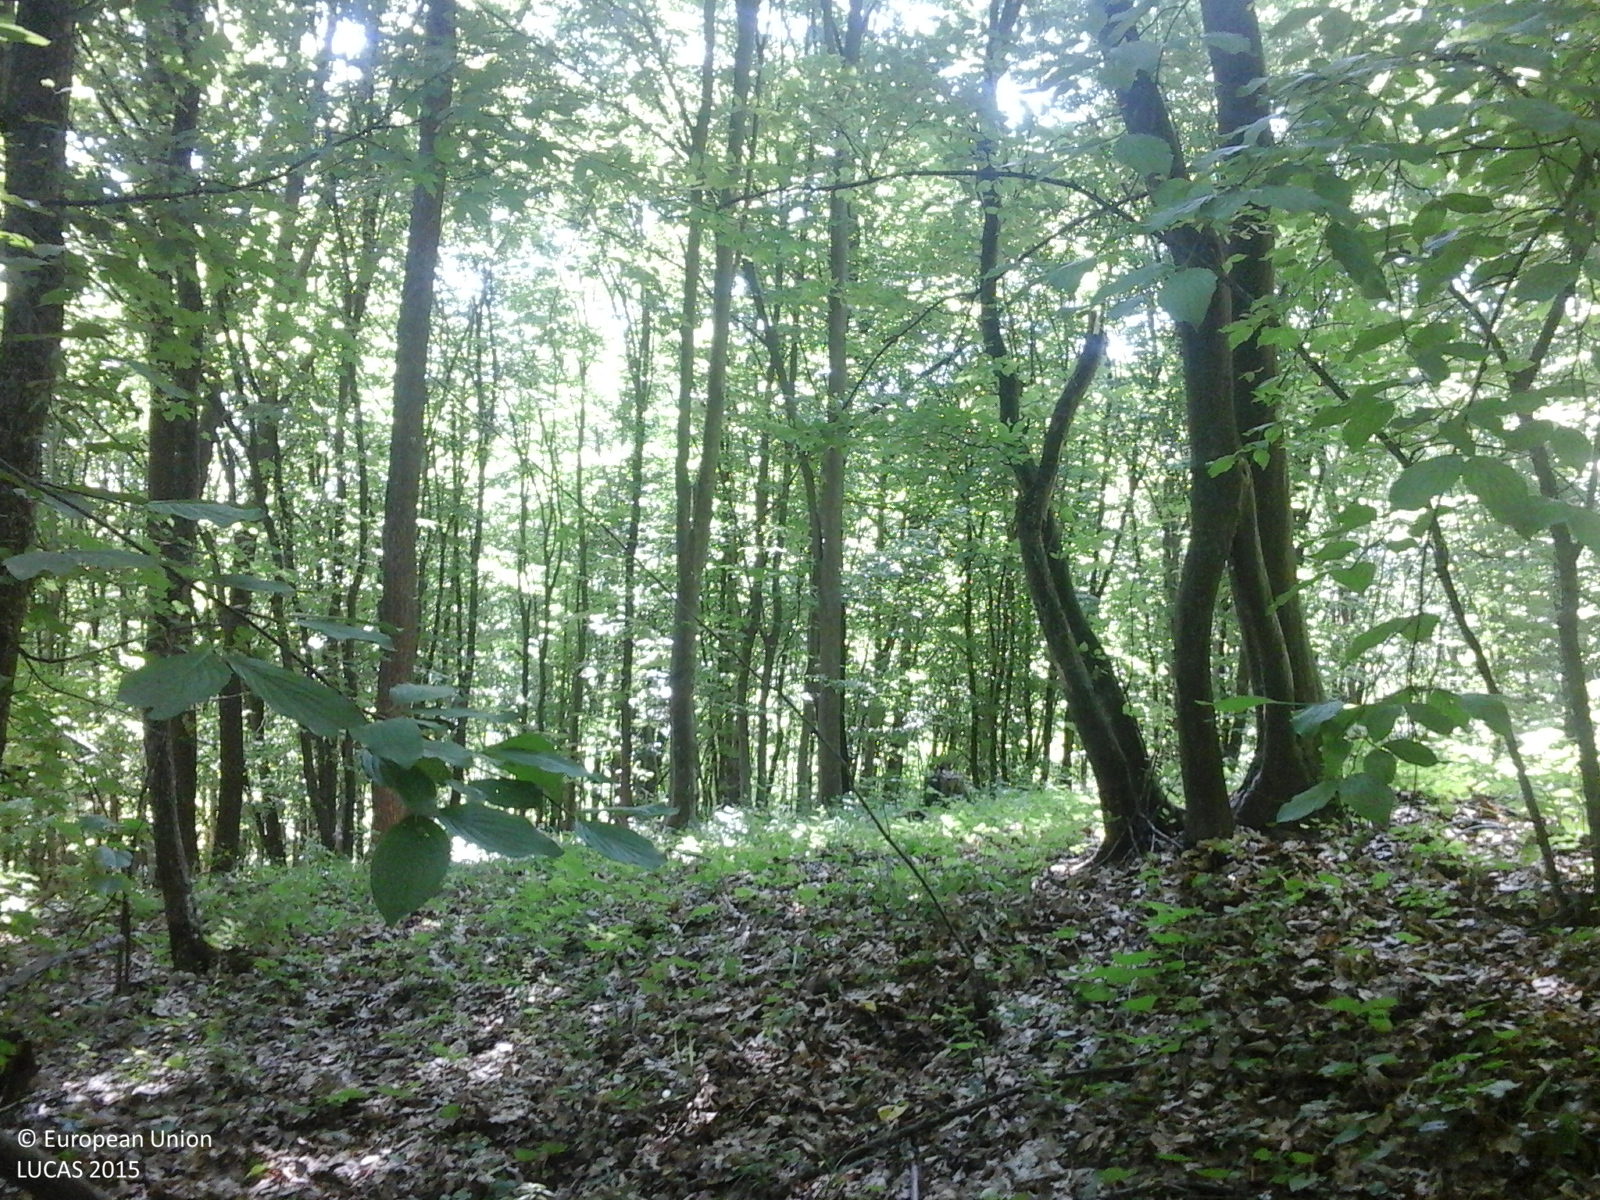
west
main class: Woodland
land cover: Broadleaved woodland
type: beech forest
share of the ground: > 75 %
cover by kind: broadleaved forest trees 100 %
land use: Forestry
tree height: > 5 m
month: June
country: RO
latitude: 45.1286
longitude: 26.1718
